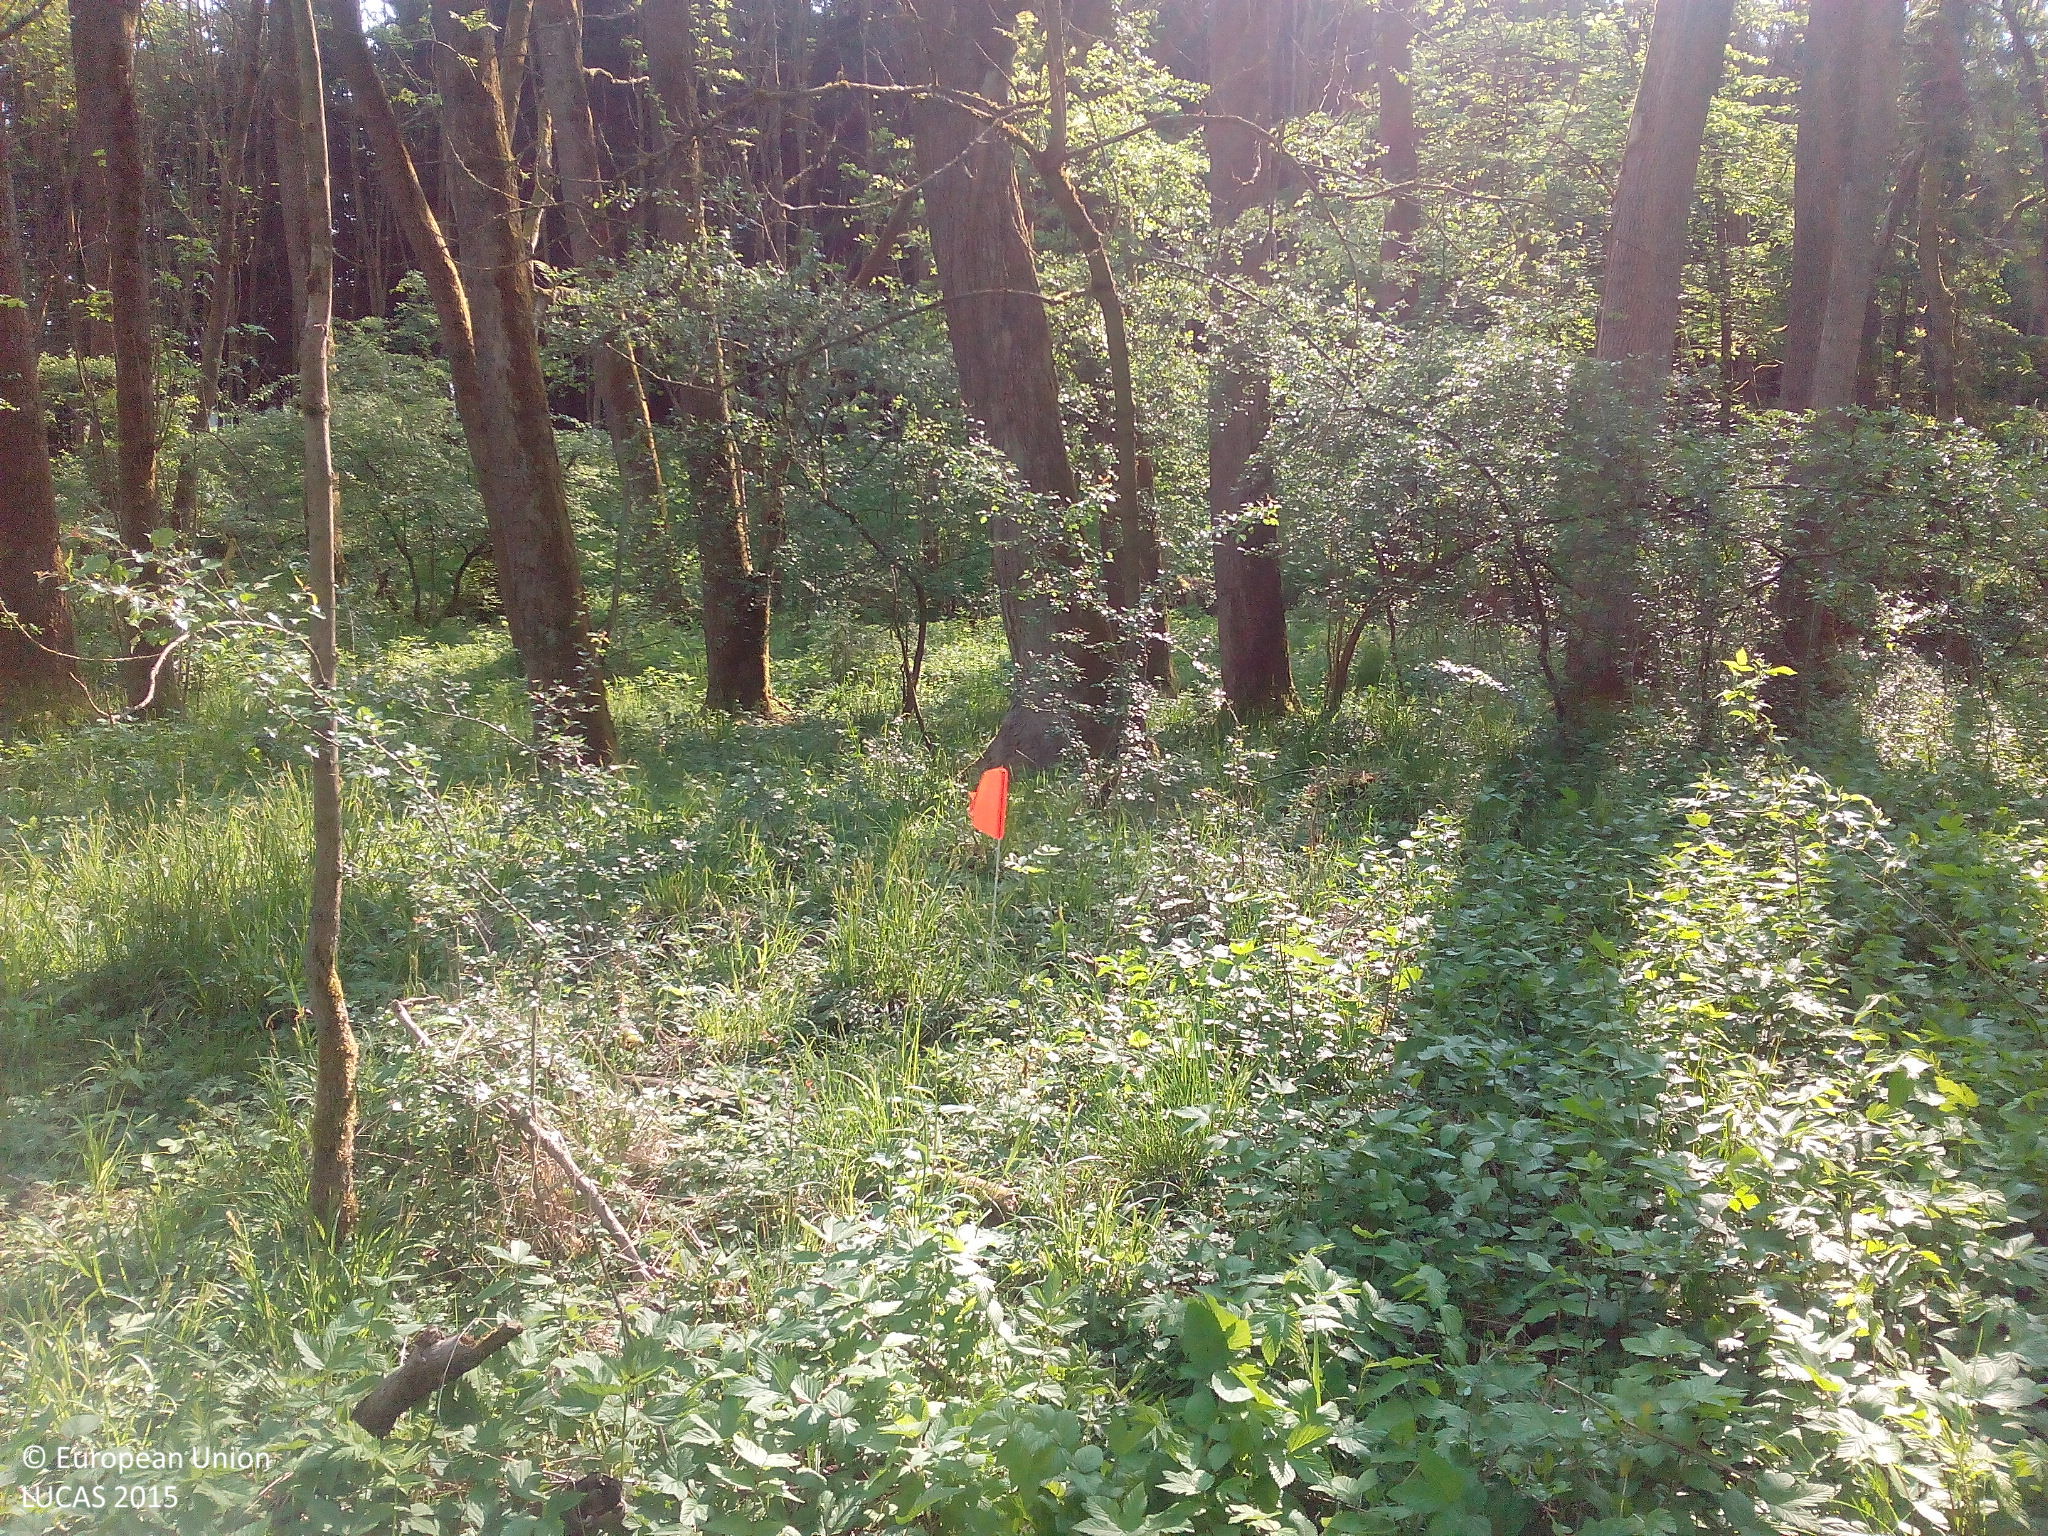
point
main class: Woodland
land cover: Broadleaved woodland
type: mesophytic deciduous forest
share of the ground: > 75 %
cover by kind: broadleaved forest trees 90 %, shrubs 5 %, herbaceous plants 5 %
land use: Forestry
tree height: > 5 m
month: May
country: DE
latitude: 49.8688
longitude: 11.4883
